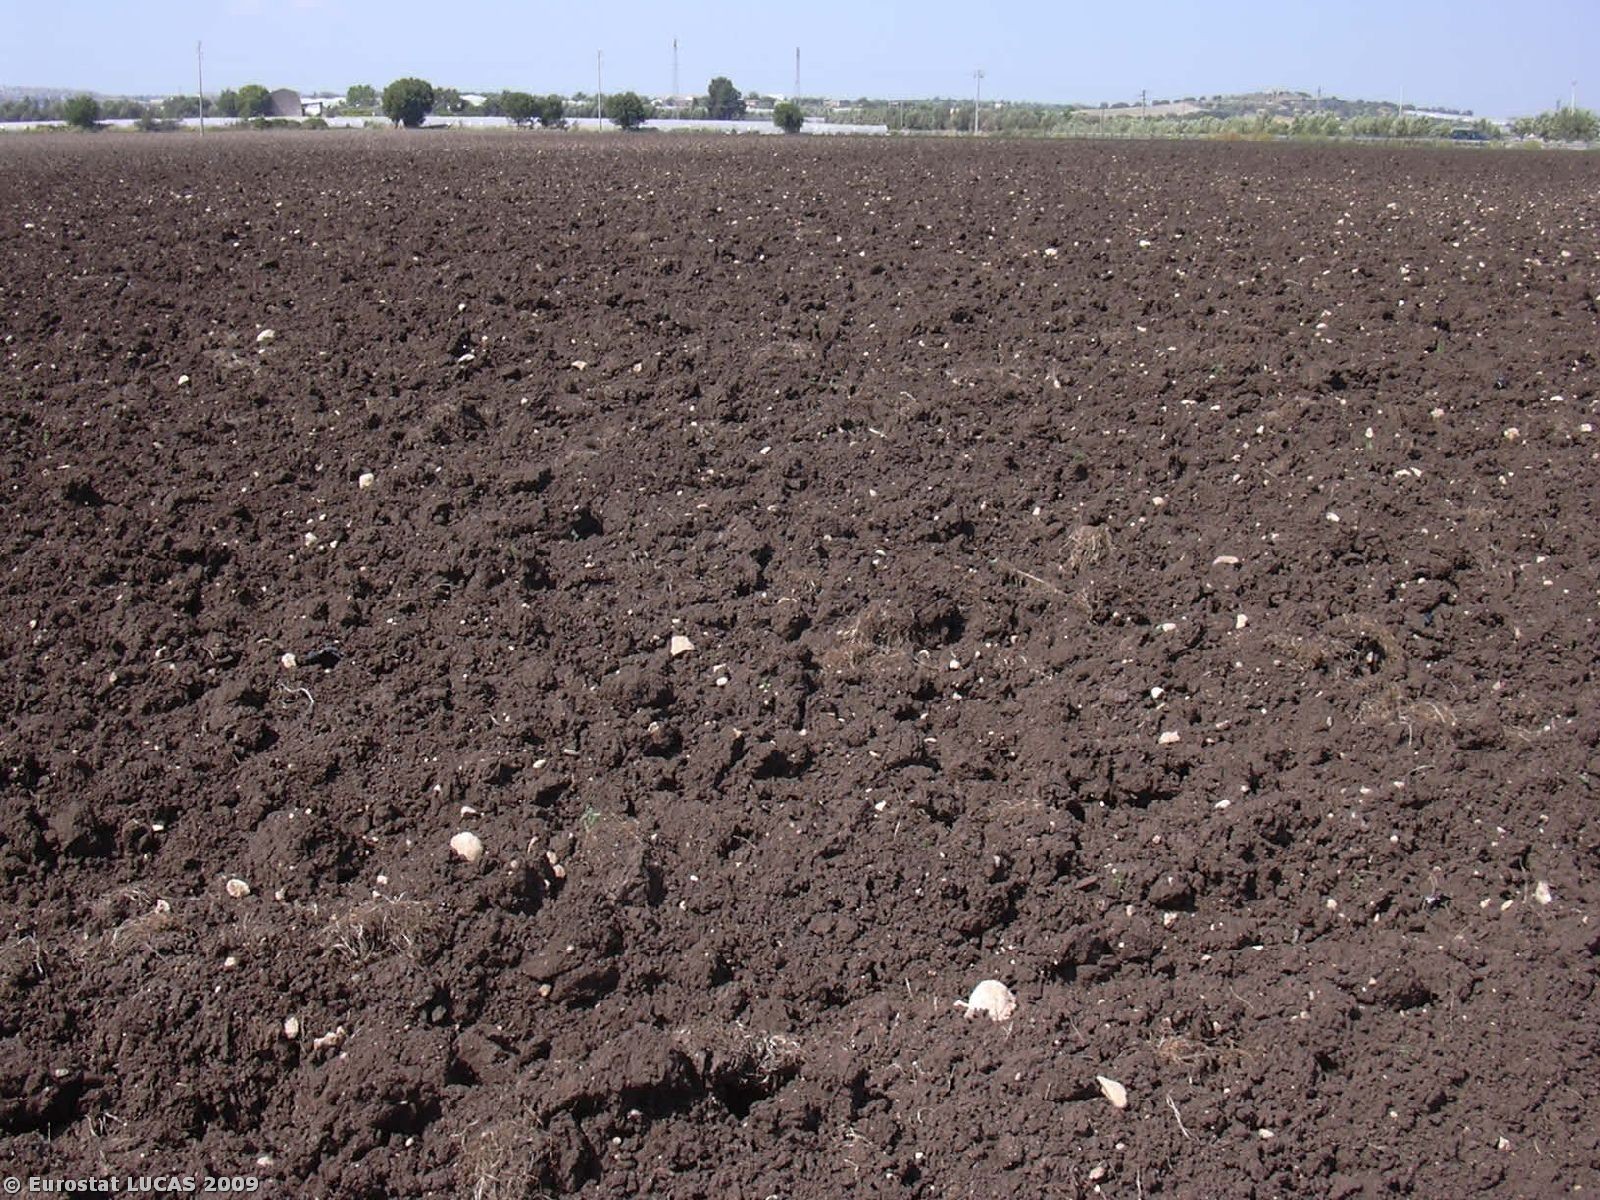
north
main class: Bare land
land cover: Bare land
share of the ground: < 10 %
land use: Agriculture (excluding fallow land and kitchen gardens)
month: May
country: IT
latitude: 36.7468
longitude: 14.9218
